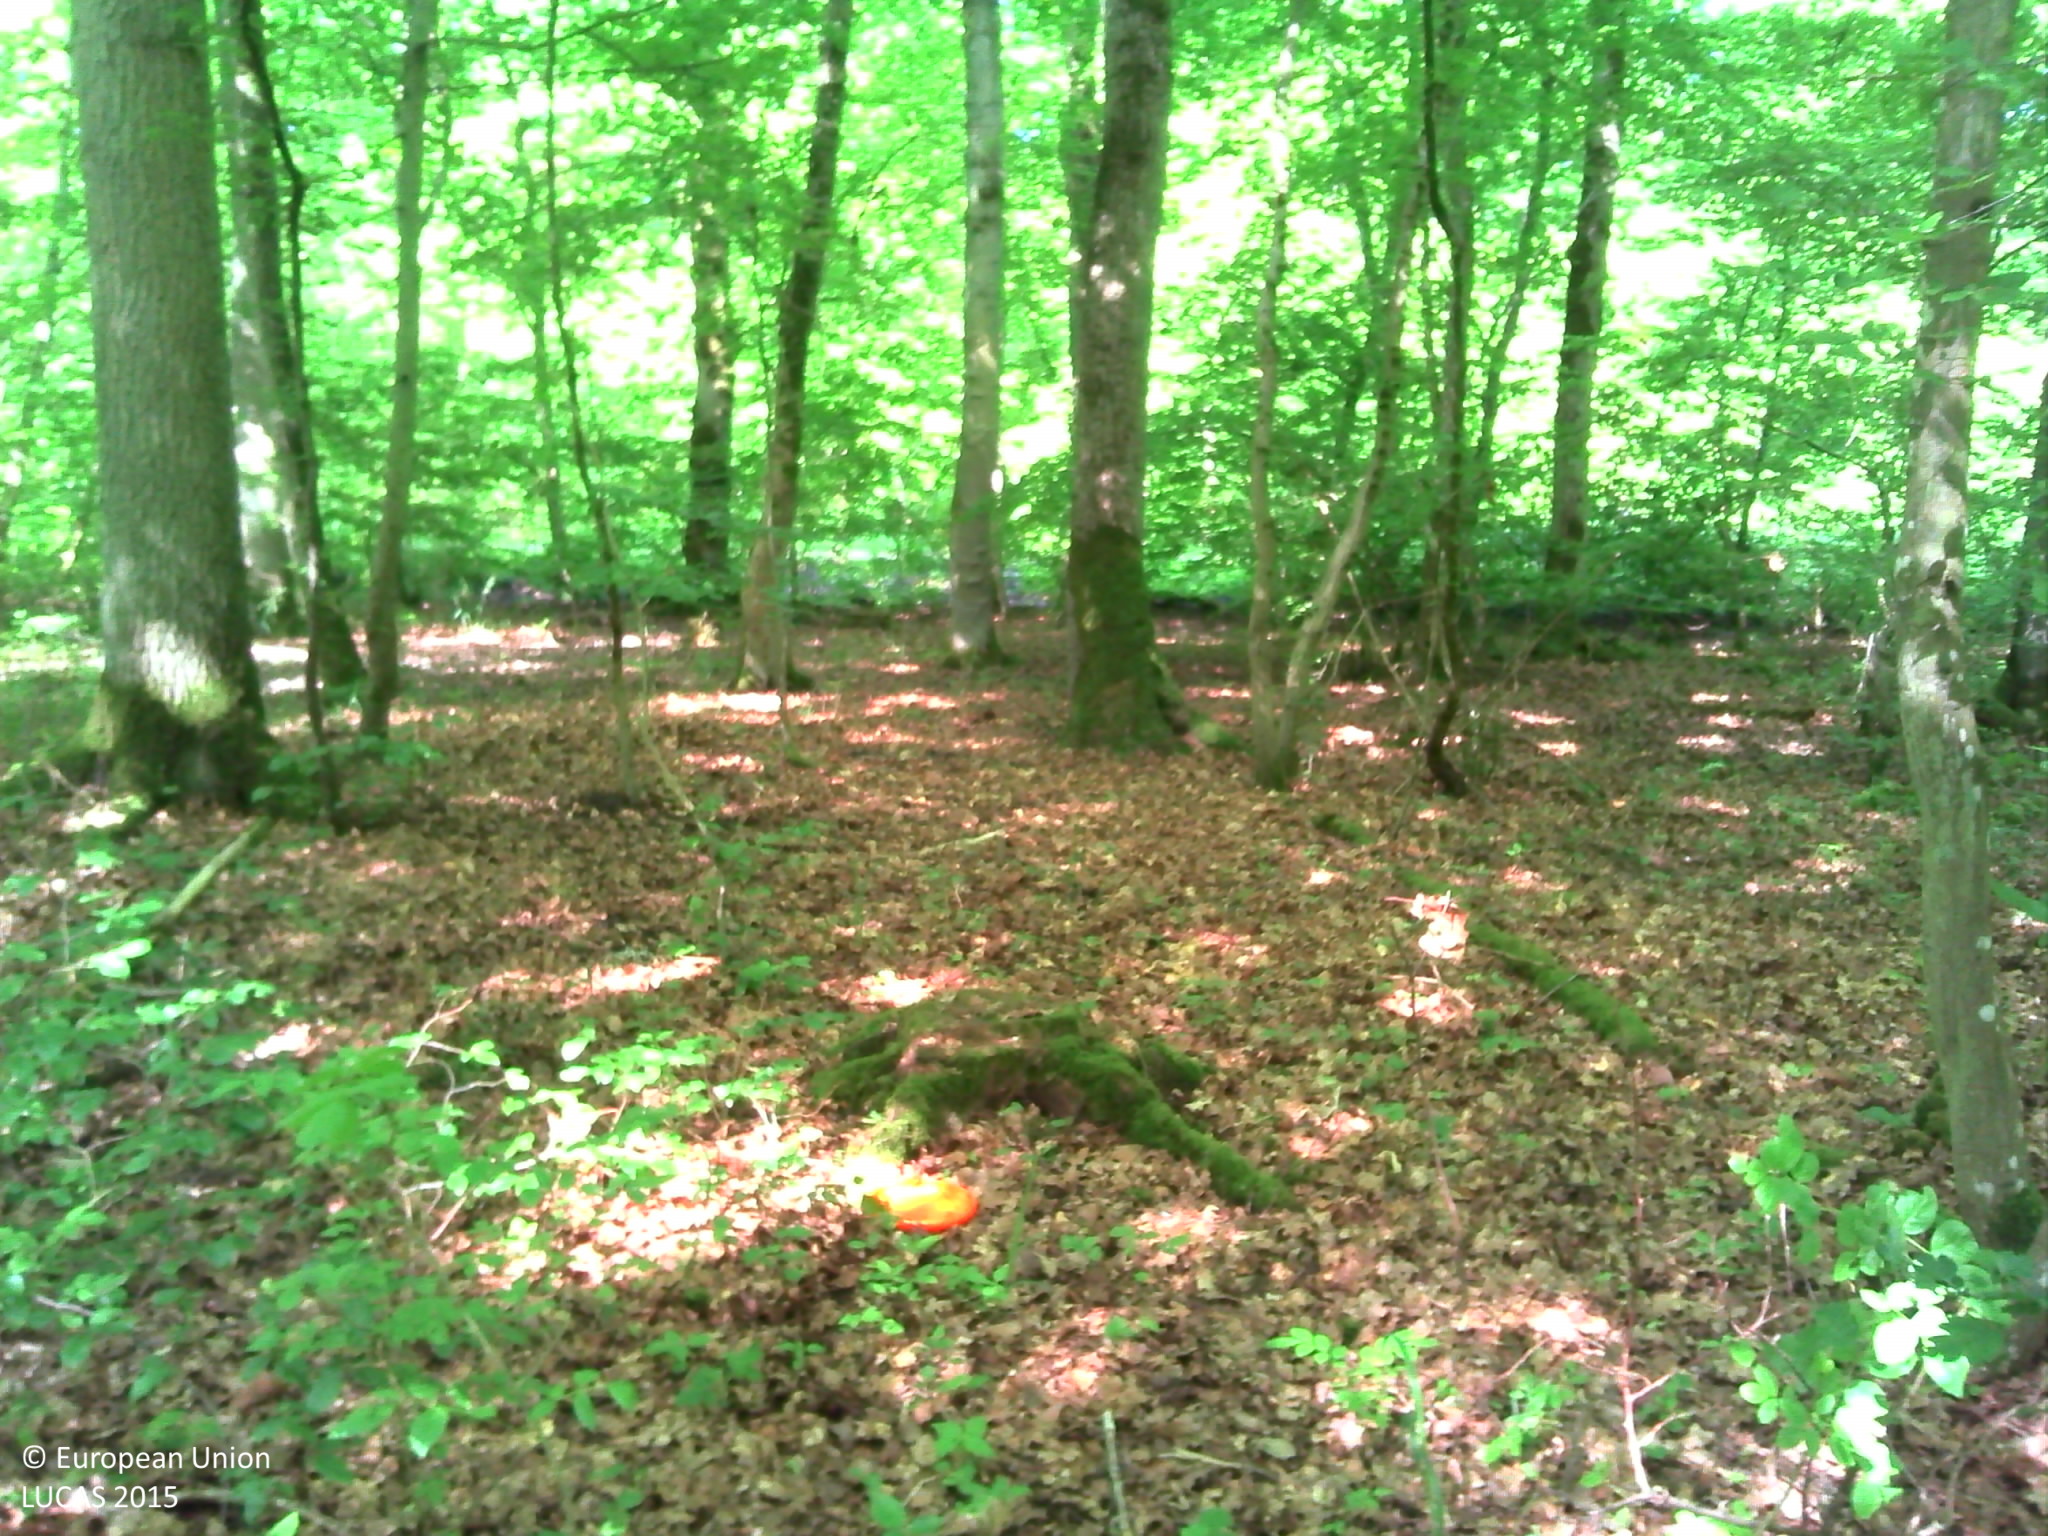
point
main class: Woodland
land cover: Broadleaved woodland
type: mesophytic deciduous forest
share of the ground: > 75 %
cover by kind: broadleaved forest trees 95 %, lichens and mosses 5 %
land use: Forestry
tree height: > 5 m
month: May
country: LU
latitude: 49.4881
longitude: 6.1204
